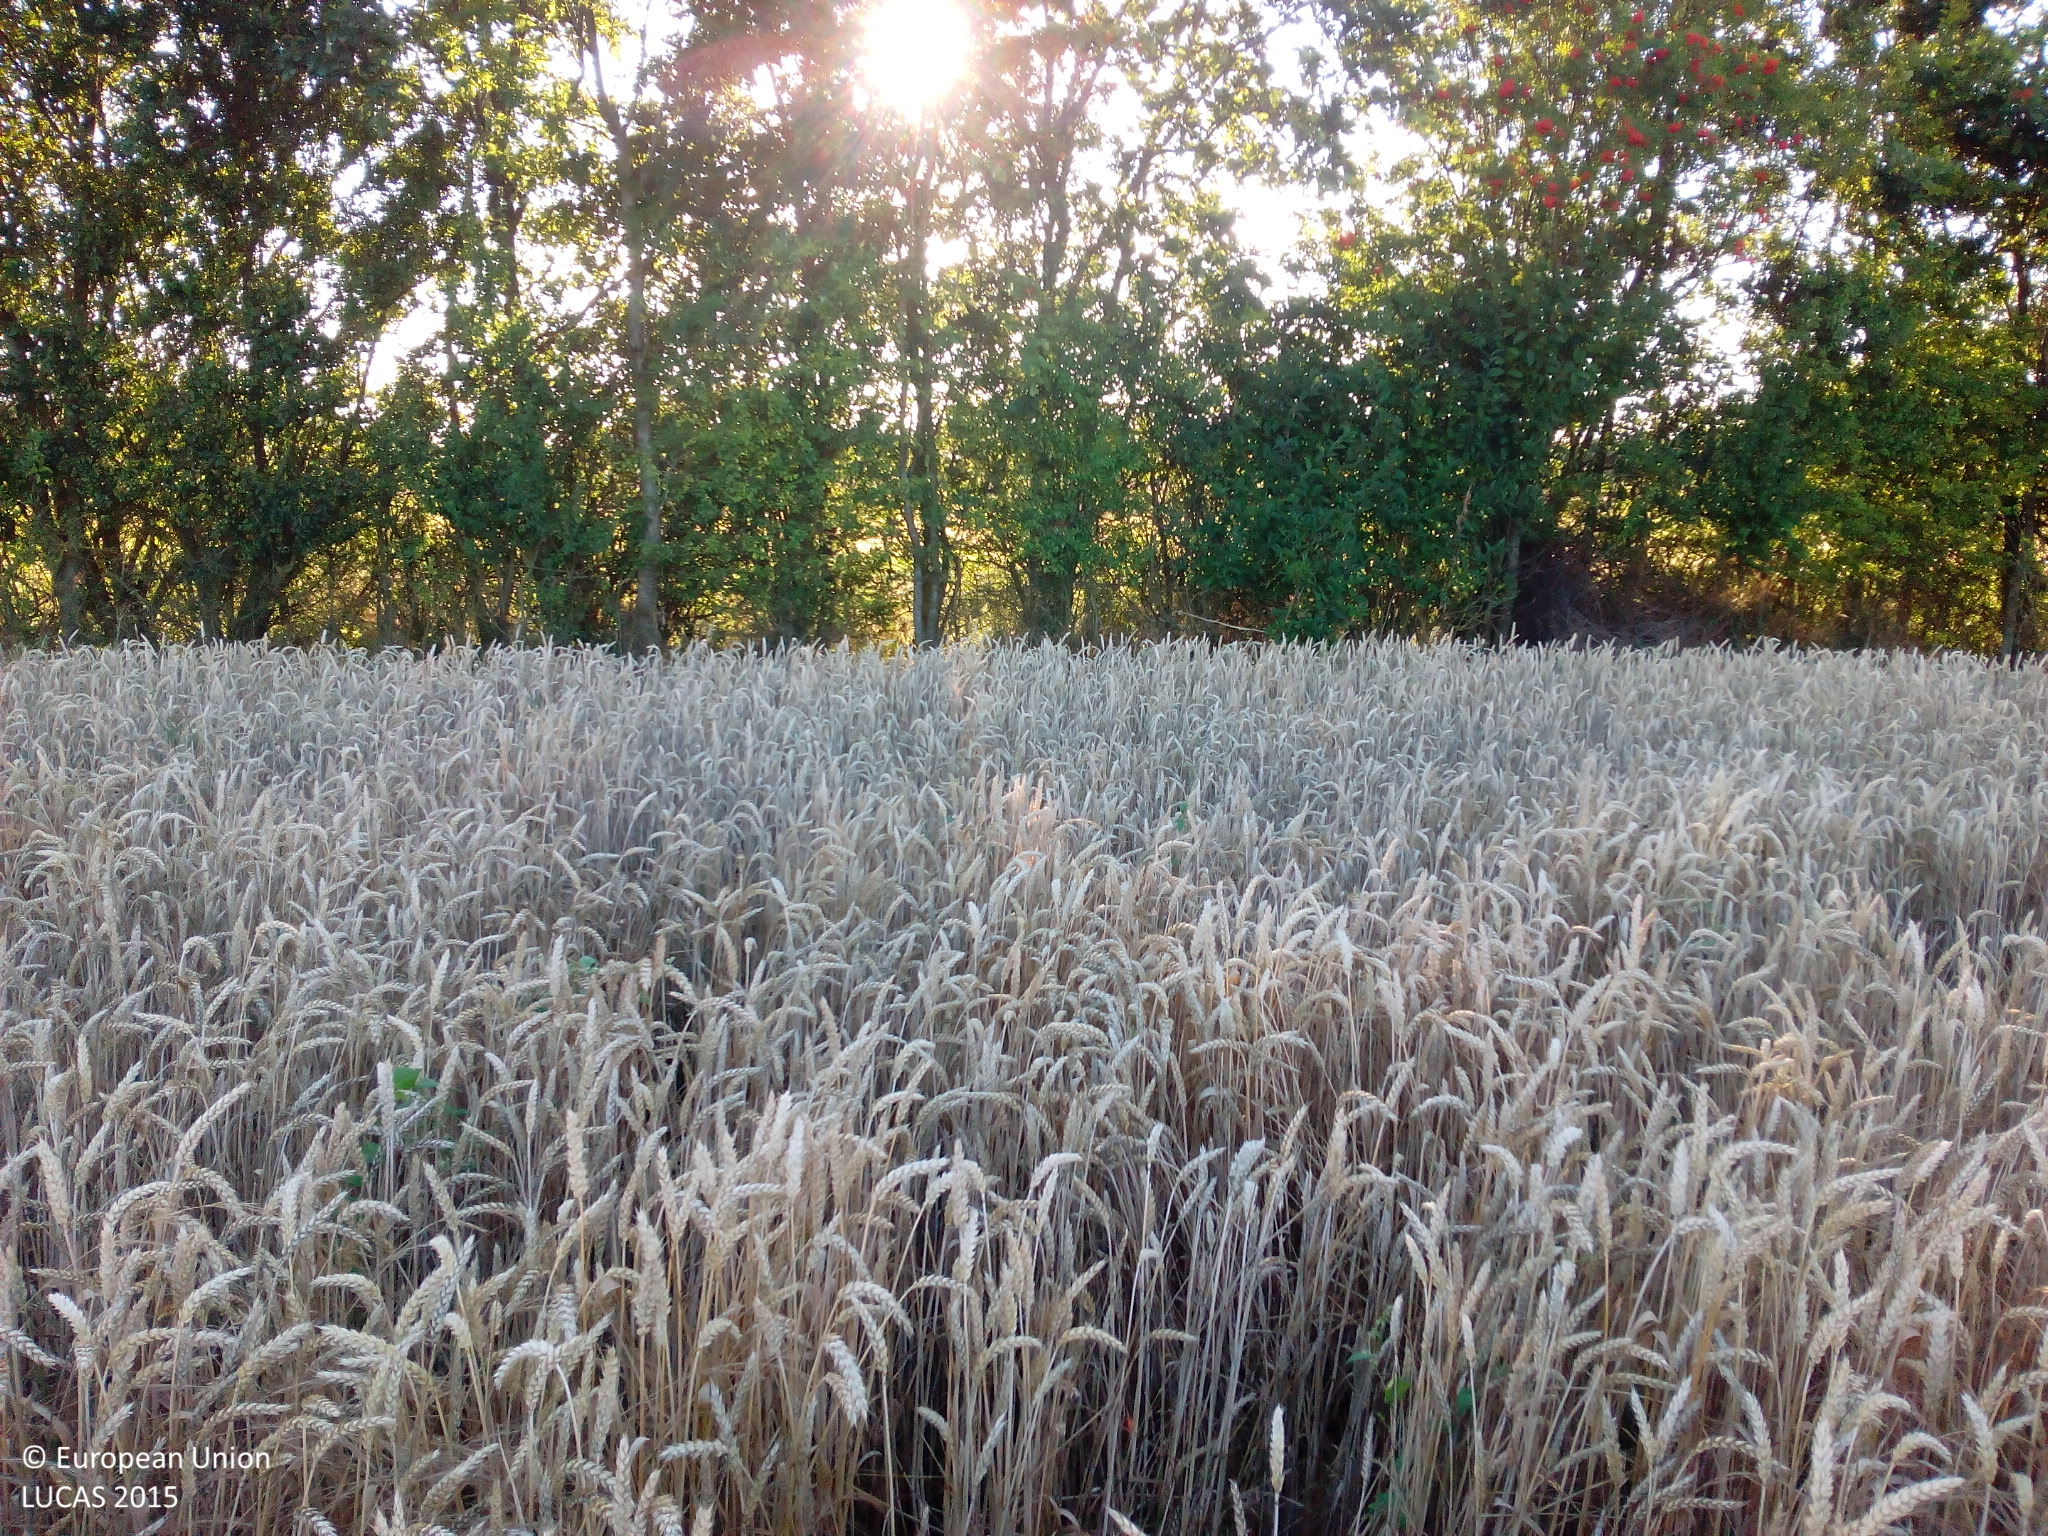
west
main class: Cropland
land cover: Common wheat
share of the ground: > 75 %
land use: Agriculture (excluding fallow land and kitchen gardens)
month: August
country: DK
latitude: 55.5824
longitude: 11.7593
